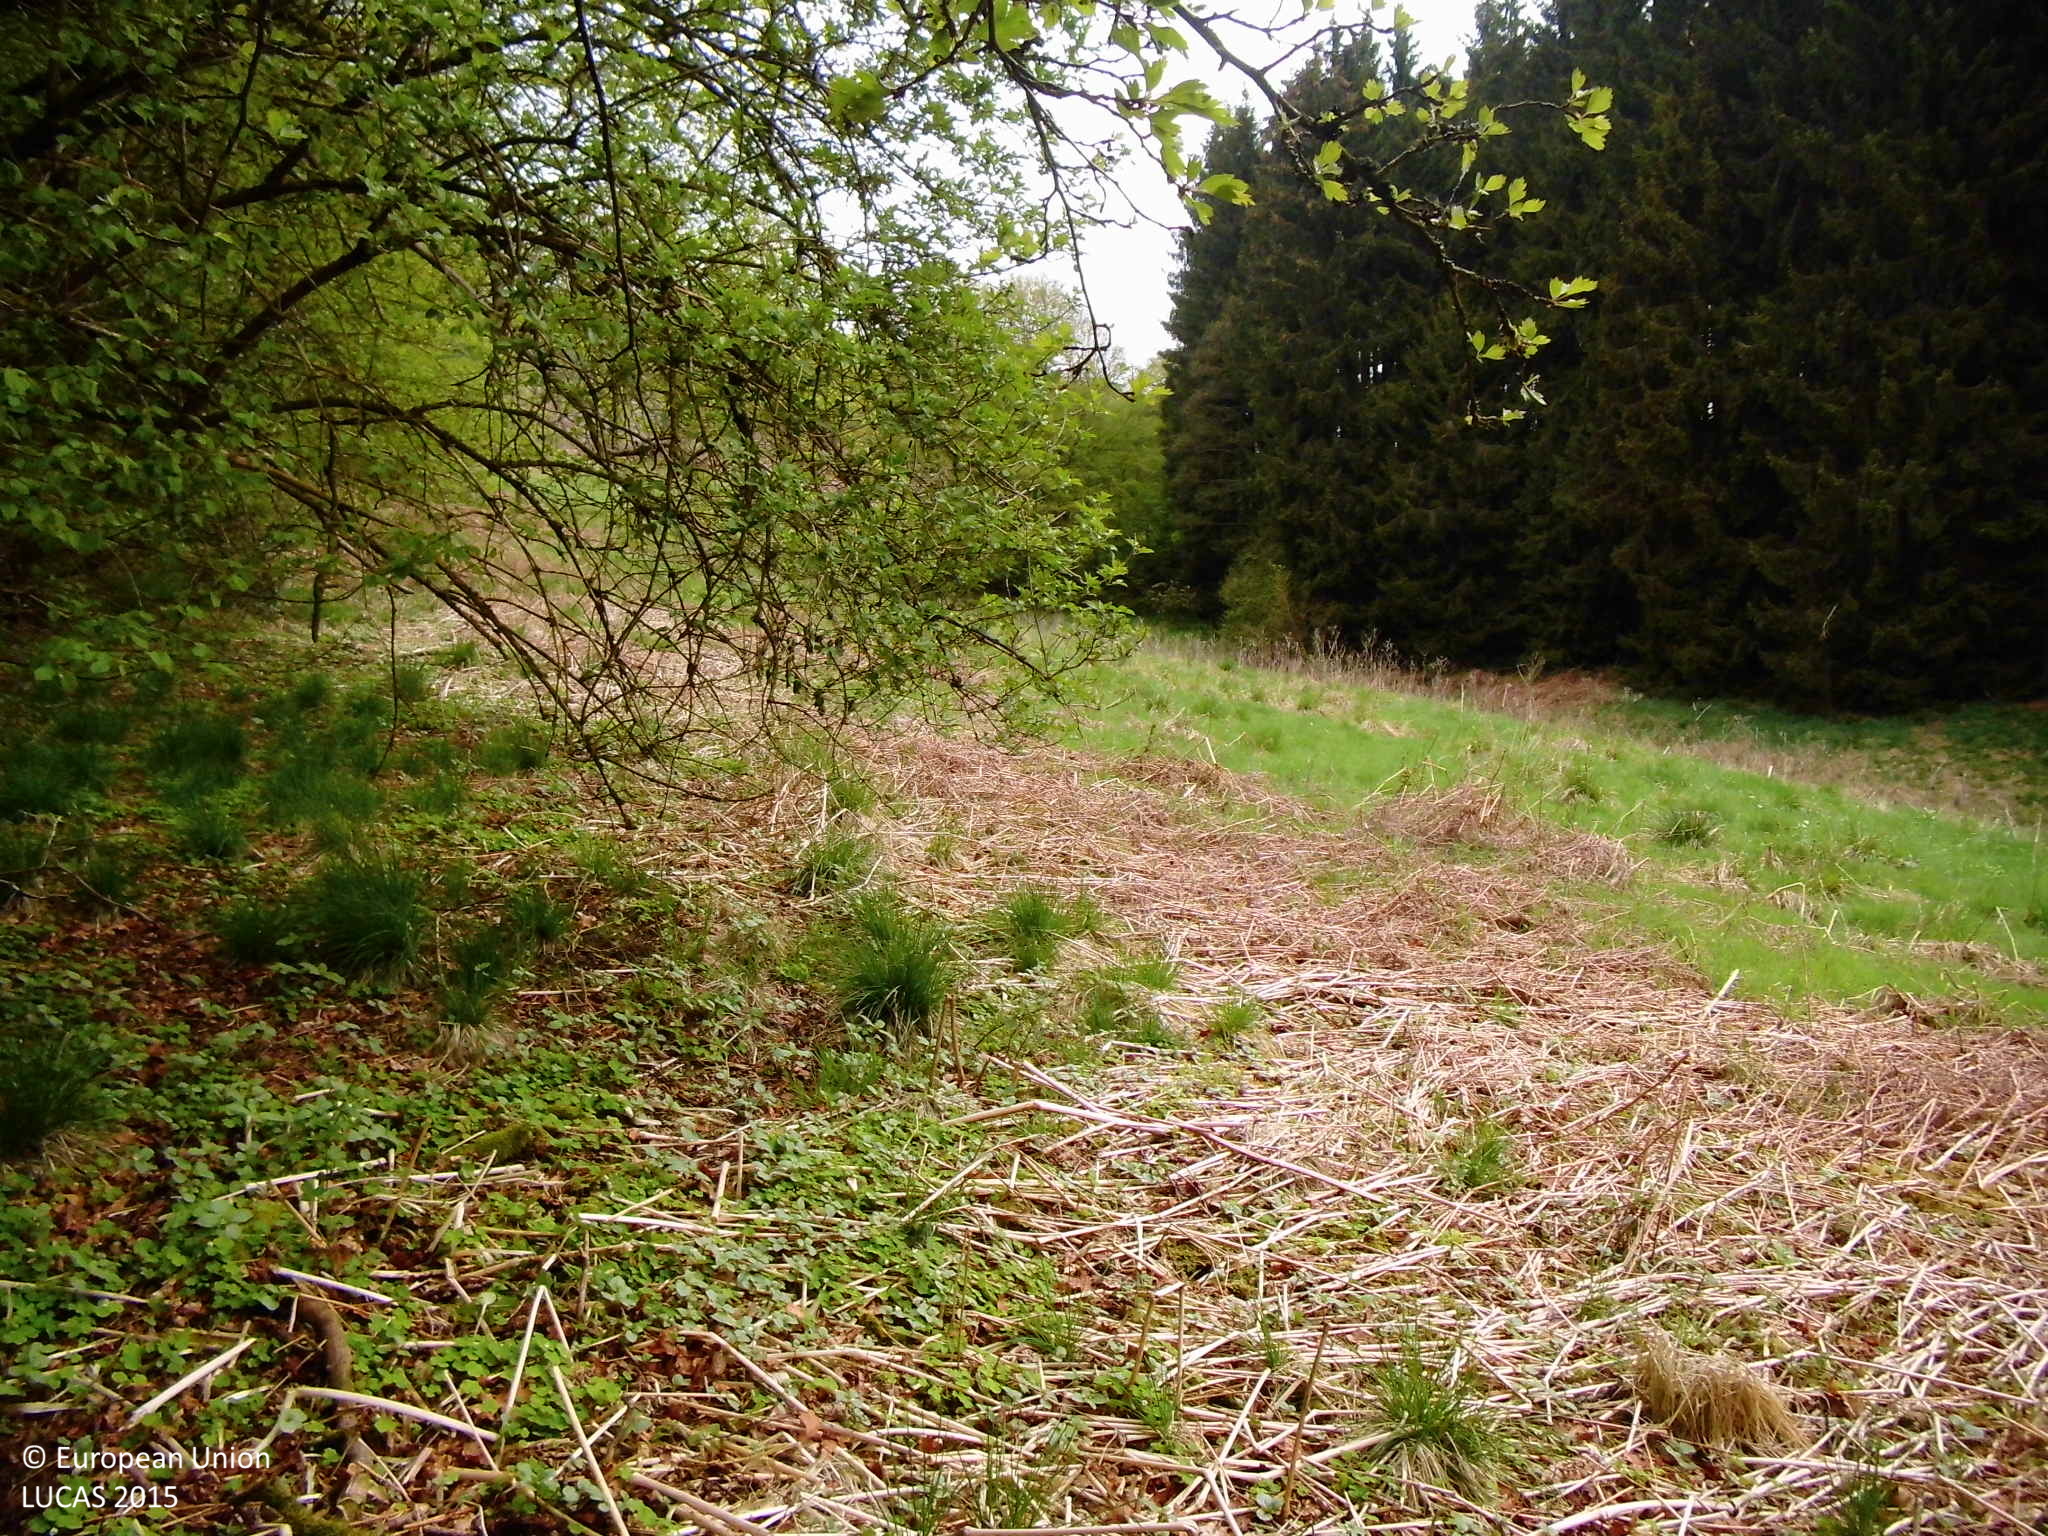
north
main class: Grassland
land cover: Grassland without tree/shrub cover
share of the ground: > 75 %
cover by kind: herbaceous plants 75 %, unconsolidated bare surface 20 %, shrubs 5 %
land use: Agriculture (excluding fallow land and kitchen gardens)
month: May
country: DE
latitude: 51.2540
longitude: 7.4928
